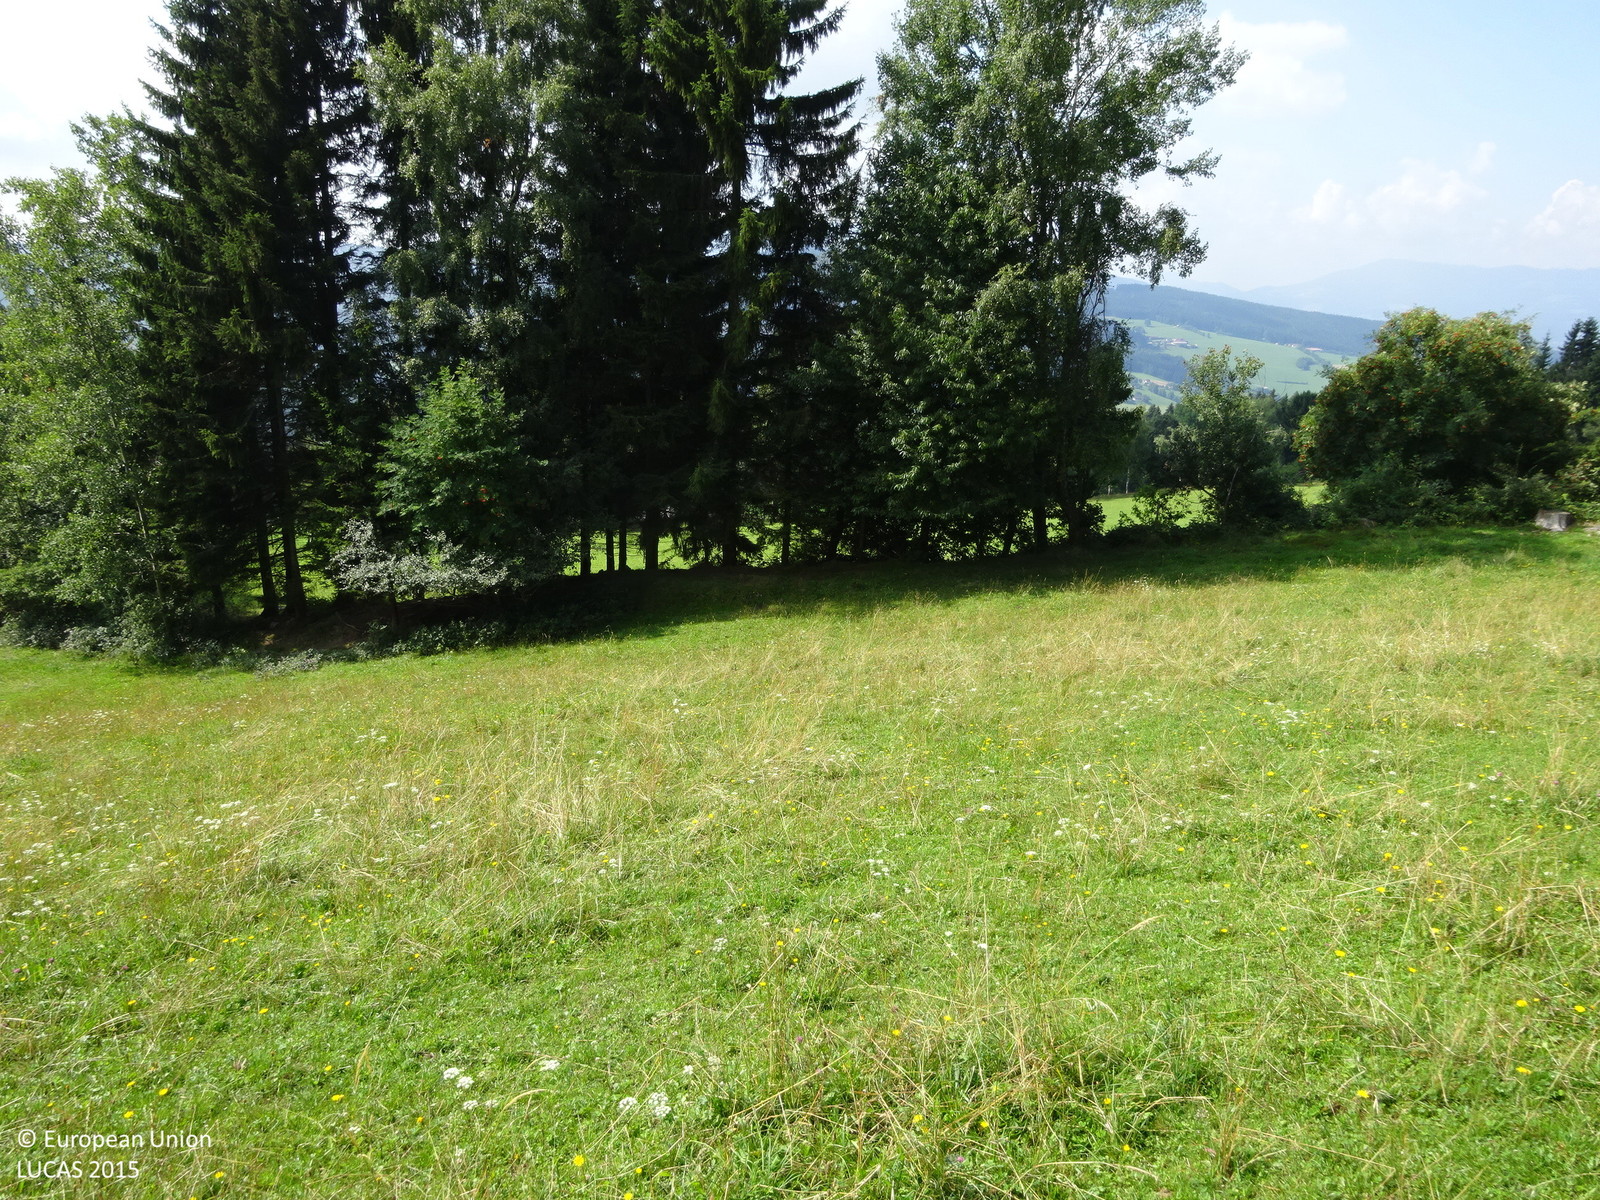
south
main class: Grassland
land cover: Grassland without tree/shrub cover
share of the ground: > 75 %
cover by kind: herbaceous plants 100 %
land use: Agriculture (excluding fallow land and kitchen gardens)
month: August
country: AT
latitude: 47.3871
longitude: 15.7637
